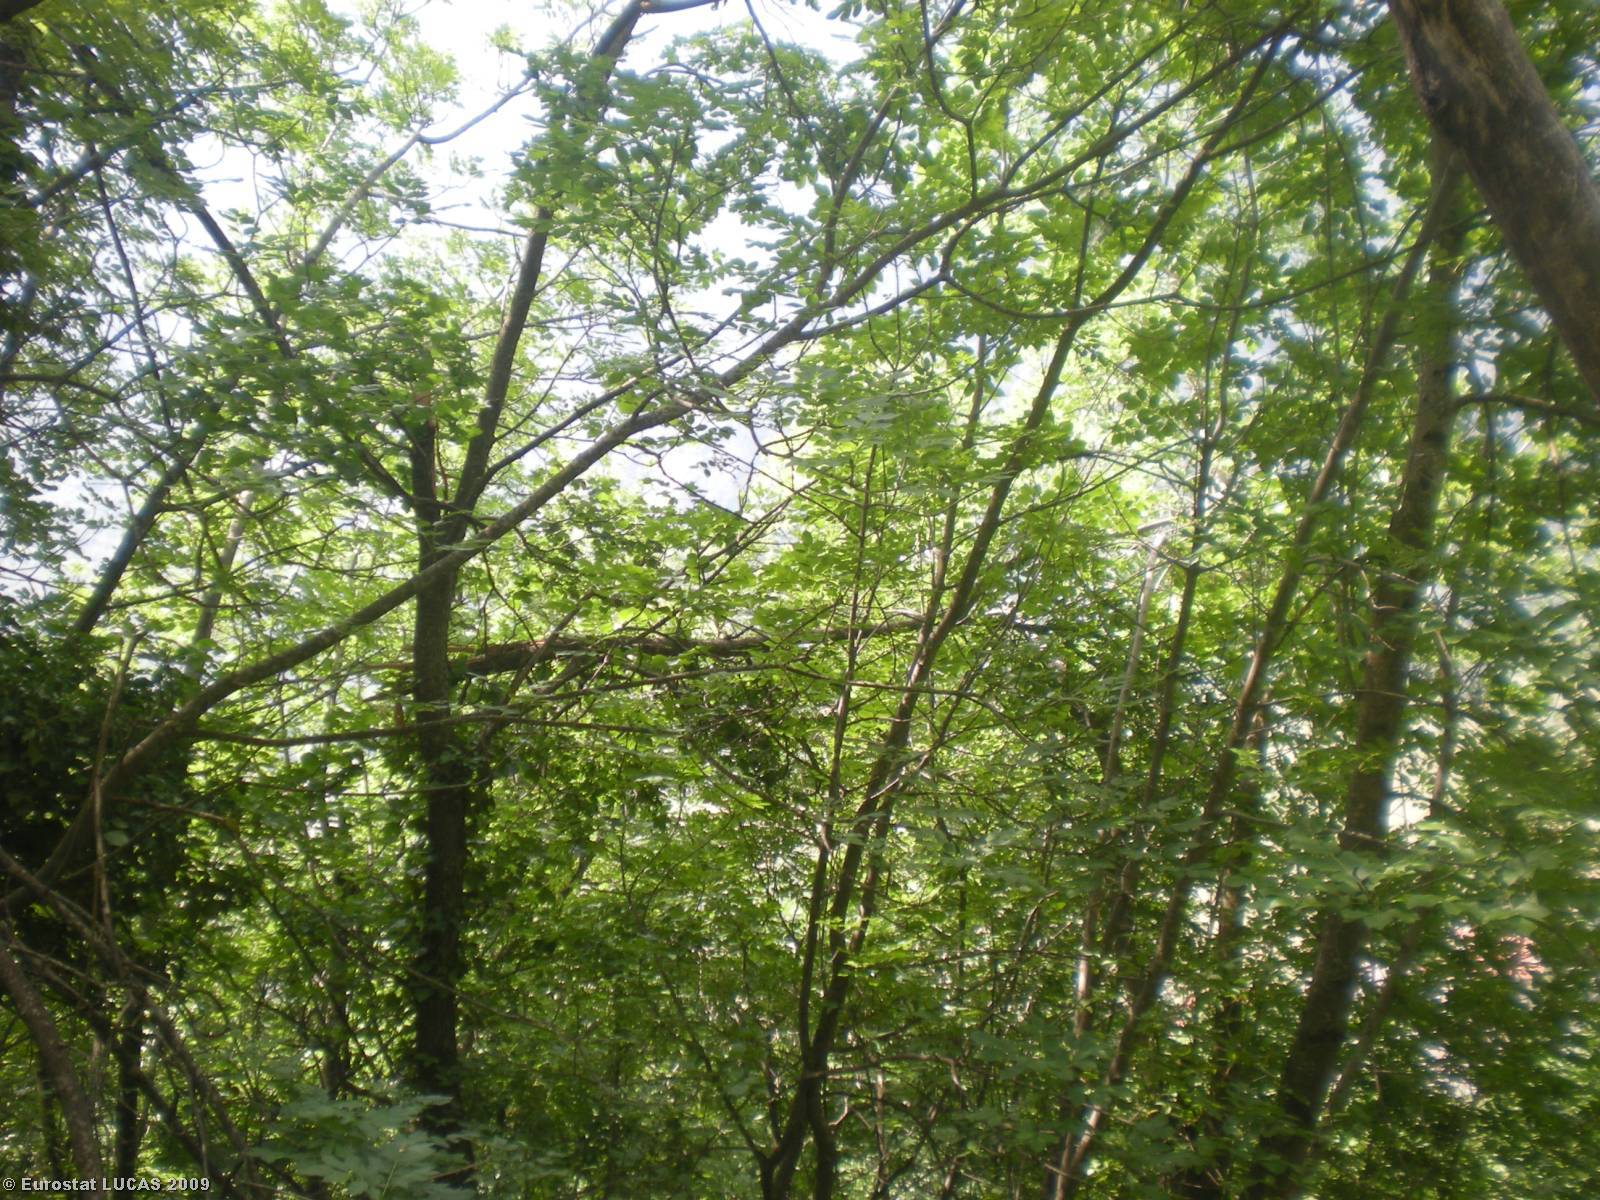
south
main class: Woodland
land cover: Broadleaved woodland
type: mesophytic deciduous forest
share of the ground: > 75 %
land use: Agriculture (excluding fallow land and kitchen gardens)
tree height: > 5 m
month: June
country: IT
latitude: 44.3124
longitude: 7.1851
